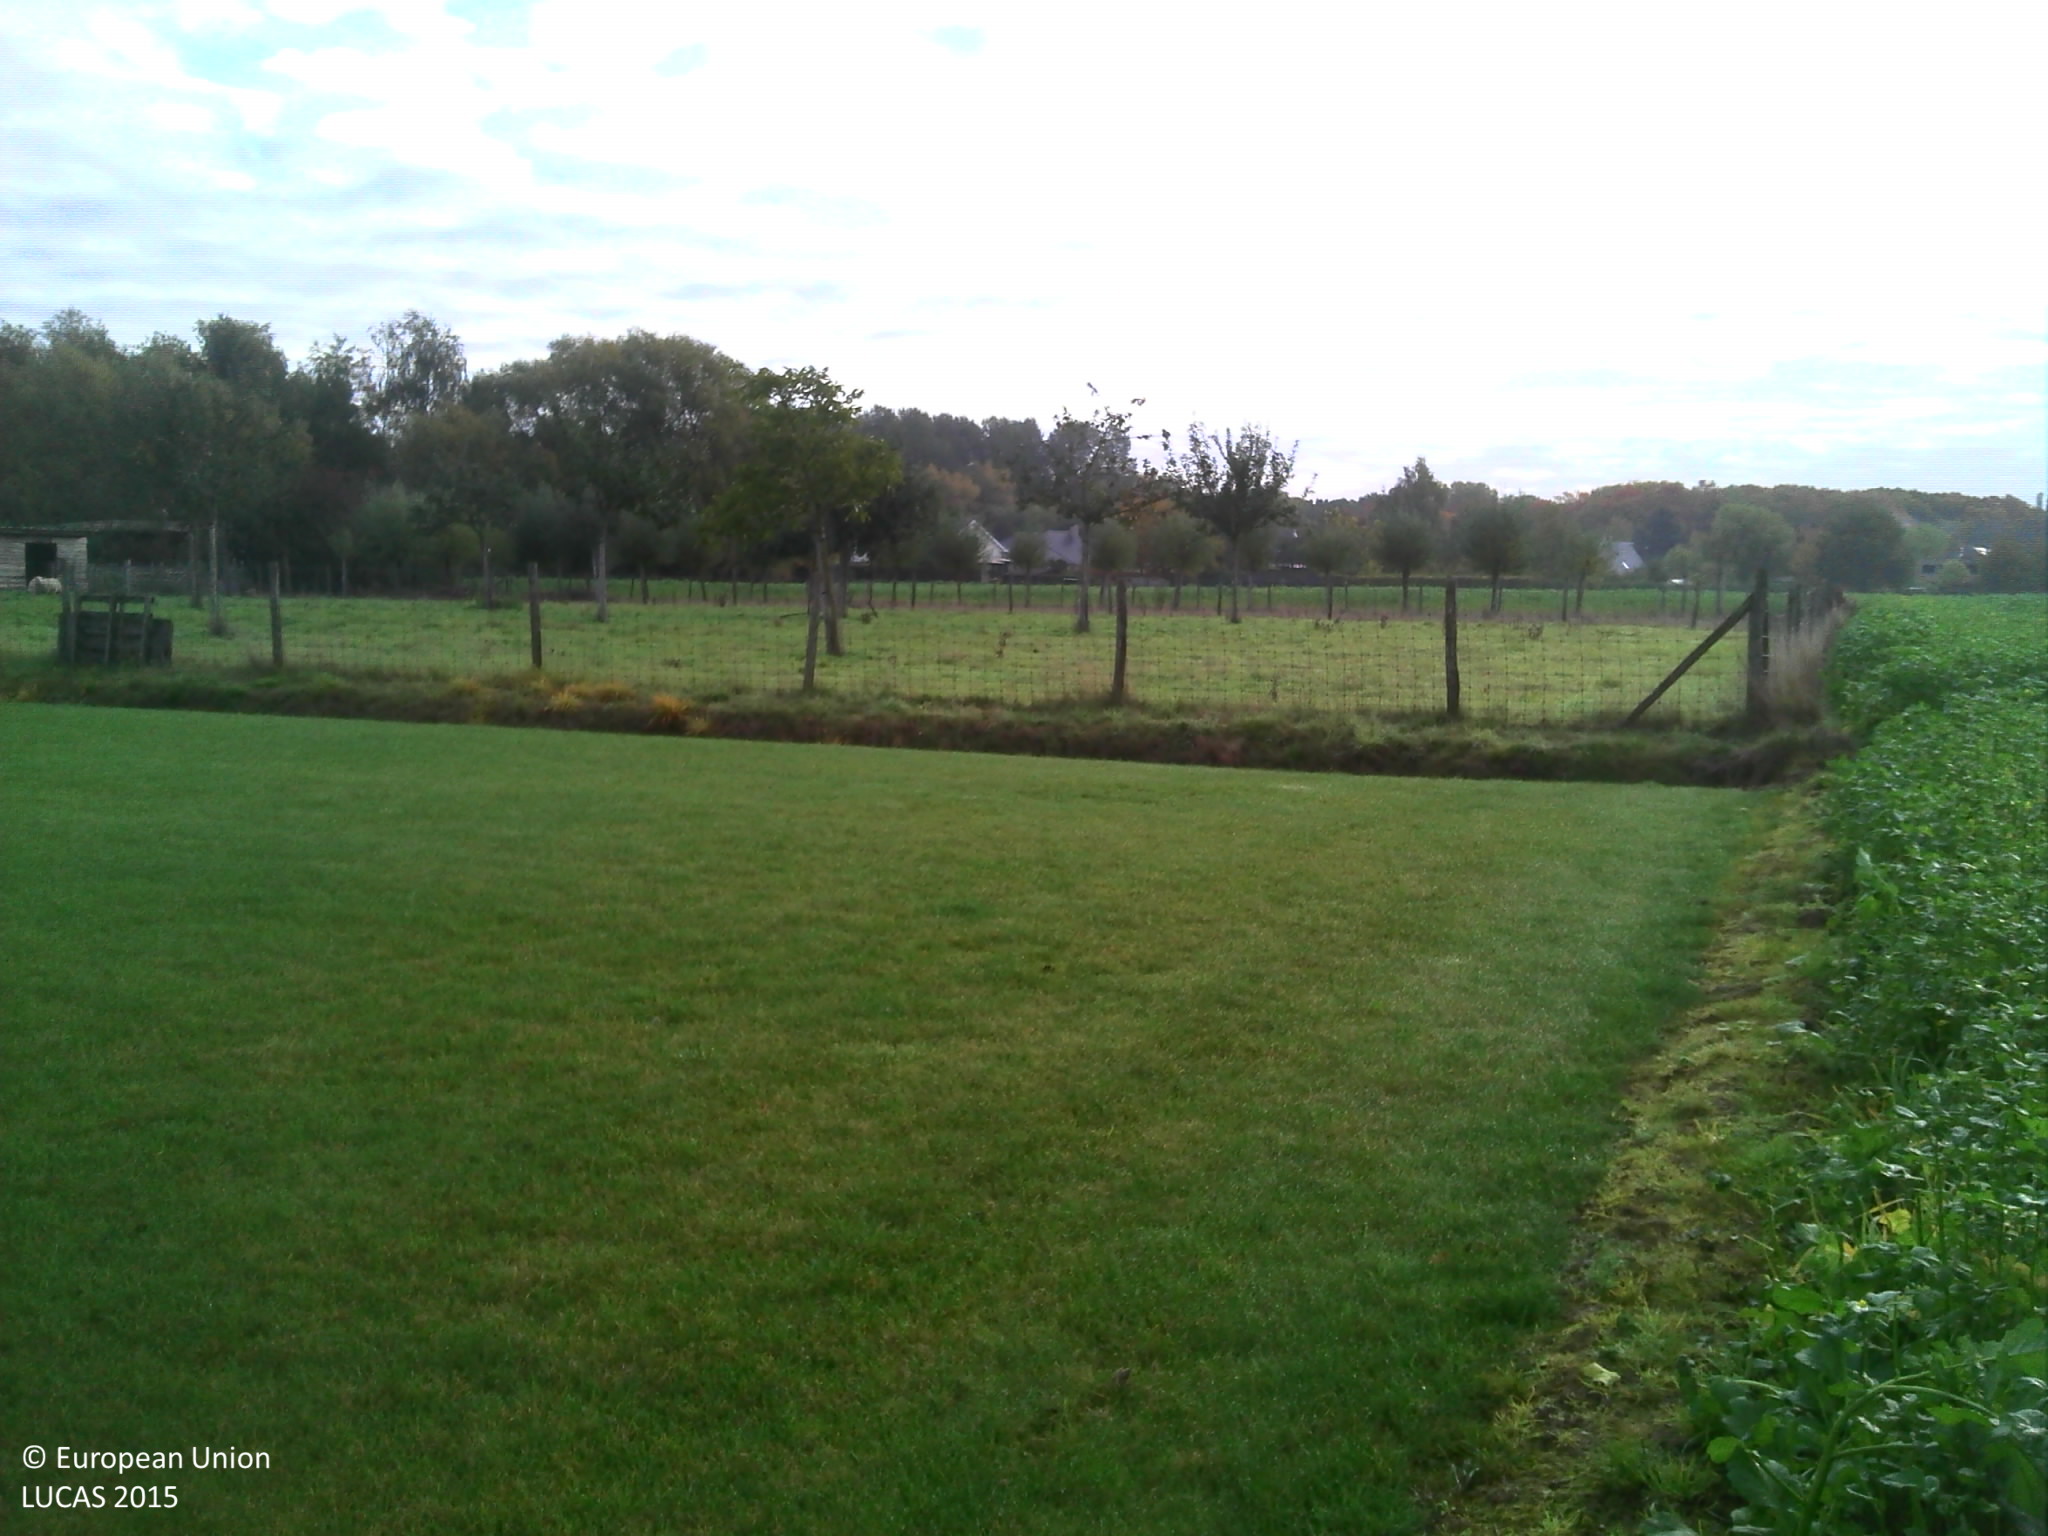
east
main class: Grassland
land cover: Grassland without tree/shrub cover
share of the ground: > 75 %
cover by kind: herbaceous plants 100 %
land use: Residential
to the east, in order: Grassland without tree/shrub cover; Fences; Grassland with sparse tree/shrub cover; Fences; Grassland without tree/shrub cover; Lines of trees; Fences; Other fibre and oleaginous crops; Ditches and canals; Artificial constructions in urban areas; Ditches and canals; Grass margins; Fences; Grassland without tree/shrub cover
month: October
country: BE
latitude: 50.9561
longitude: 4.5720
